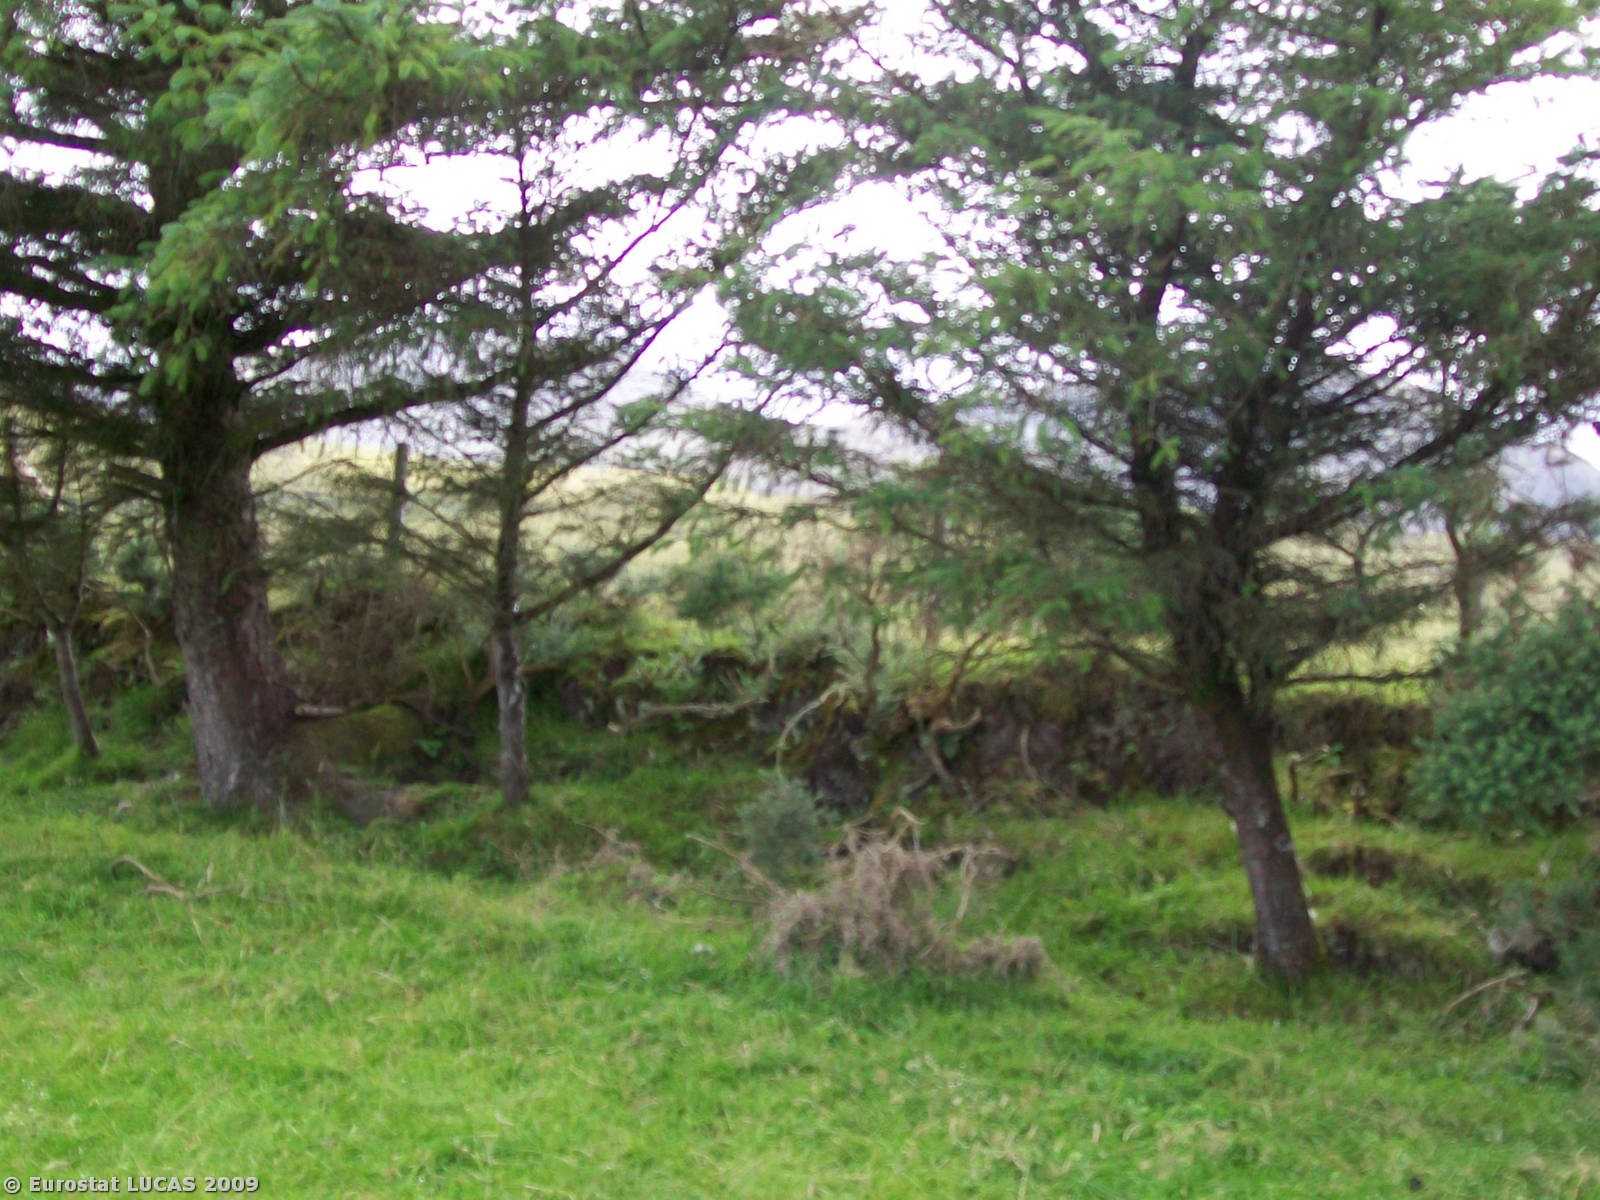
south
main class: Grassland
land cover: Grassland without tree/shrub cover
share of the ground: > 75 %
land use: Agriculture (excluding fallow land and kitchen gardens)
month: July
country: IE
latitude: 53.6982
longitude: -9.6405
